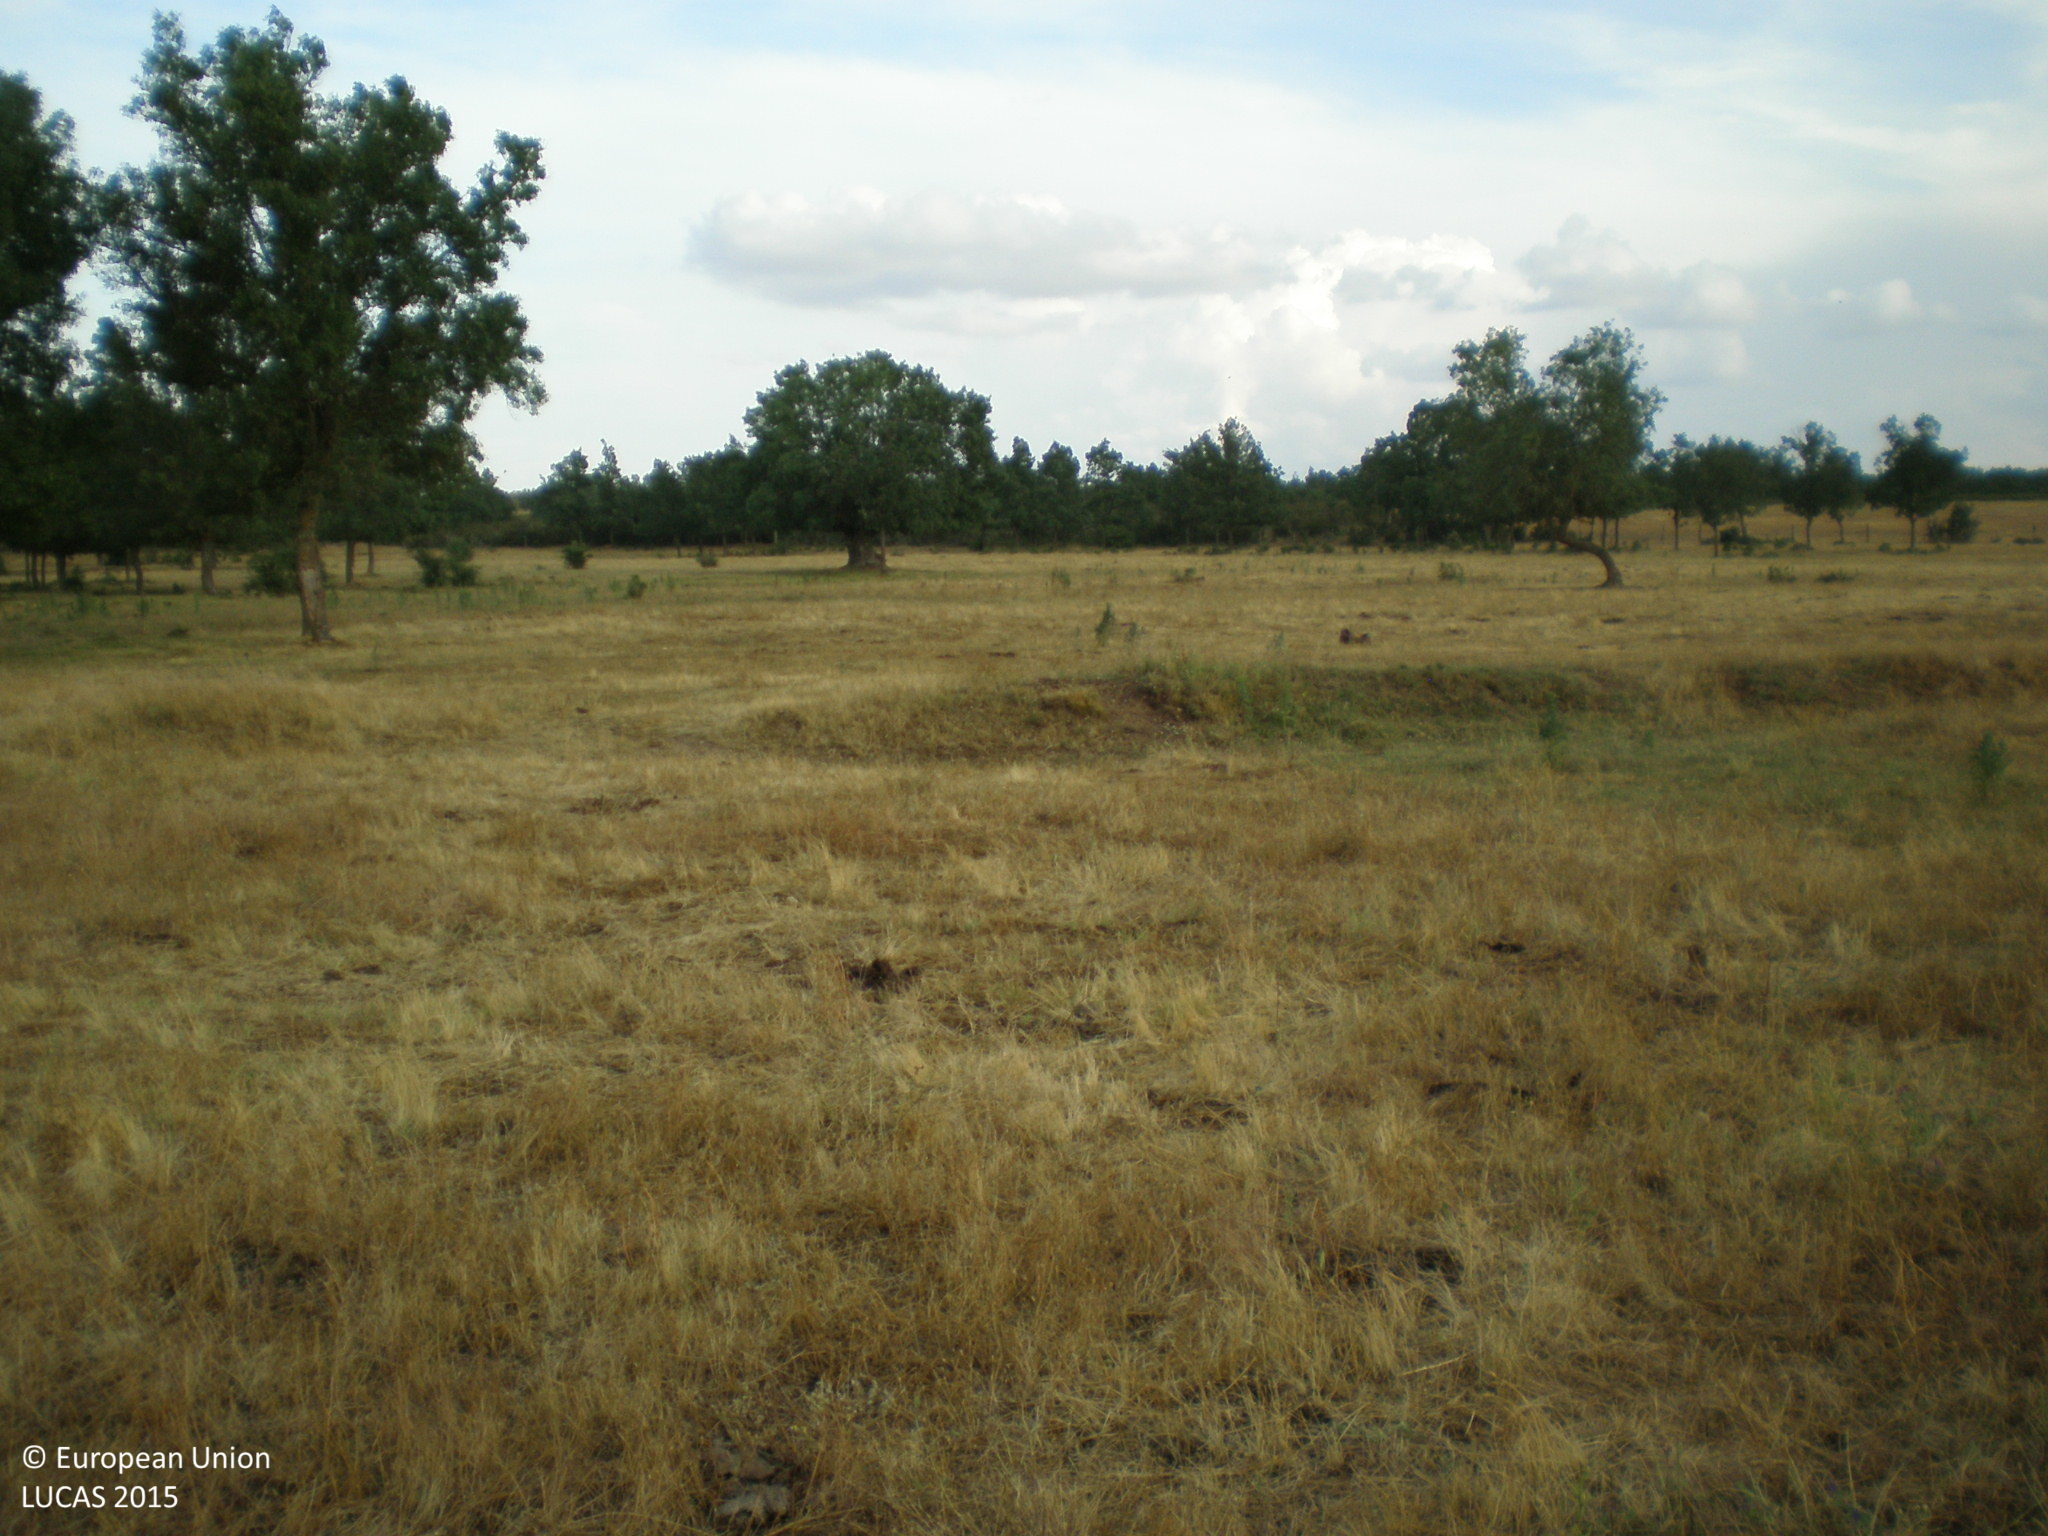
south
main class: Grassland
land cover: Grassland without tree/shrub cover
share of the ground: > 75 %
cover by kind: herbaceous plants 100 %
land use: Agriculture (excluding fallow land and kitchen gardens)
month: June
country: ES
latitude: 41.2082
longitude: -5.7655
